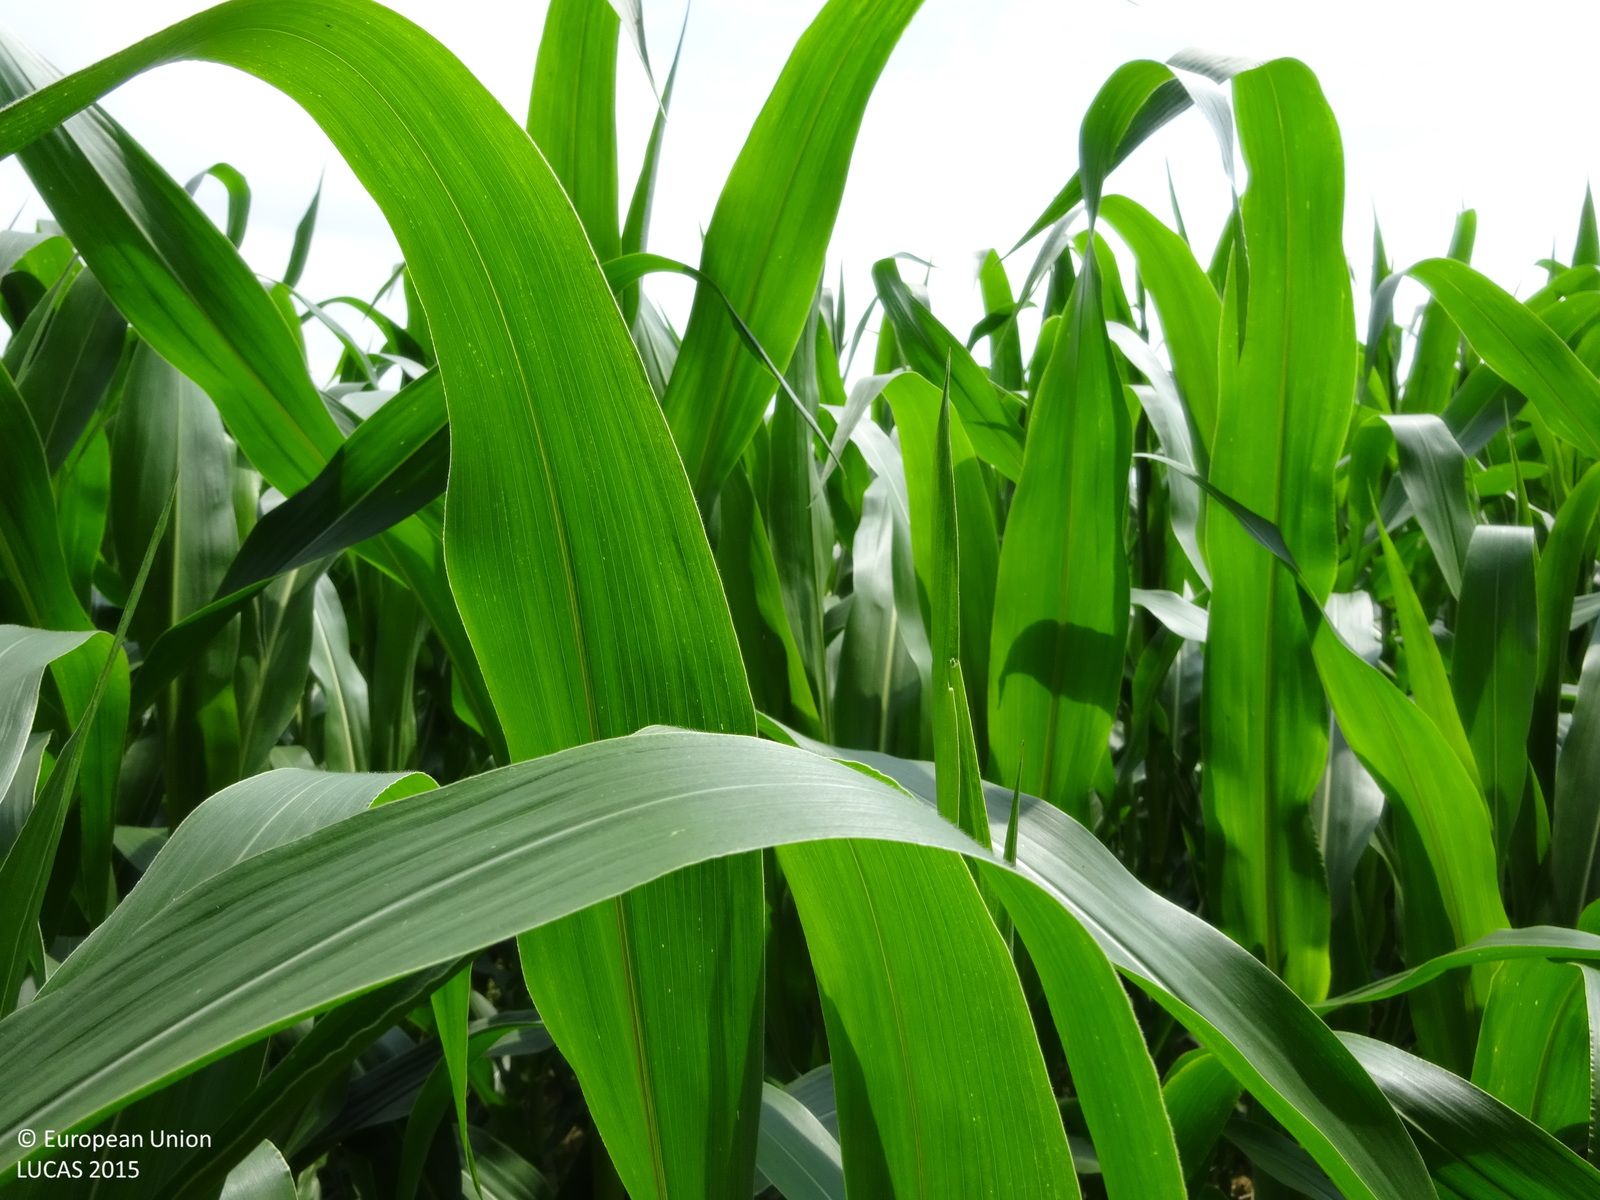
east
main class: Cropland
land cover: Maize
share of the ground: > 75 %
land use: Agriculture (excluding fallow land and kitchen gardens)
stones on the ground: < 10 %
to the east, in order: Maize; Grass margins; Paved roads, cycling and walking lanes; Grass margins; Ditches and canals; Grass margins; Fences; Grass margins; Nurseries; Barley
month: July
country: AT
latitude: 46.9423
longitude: 15.9782
